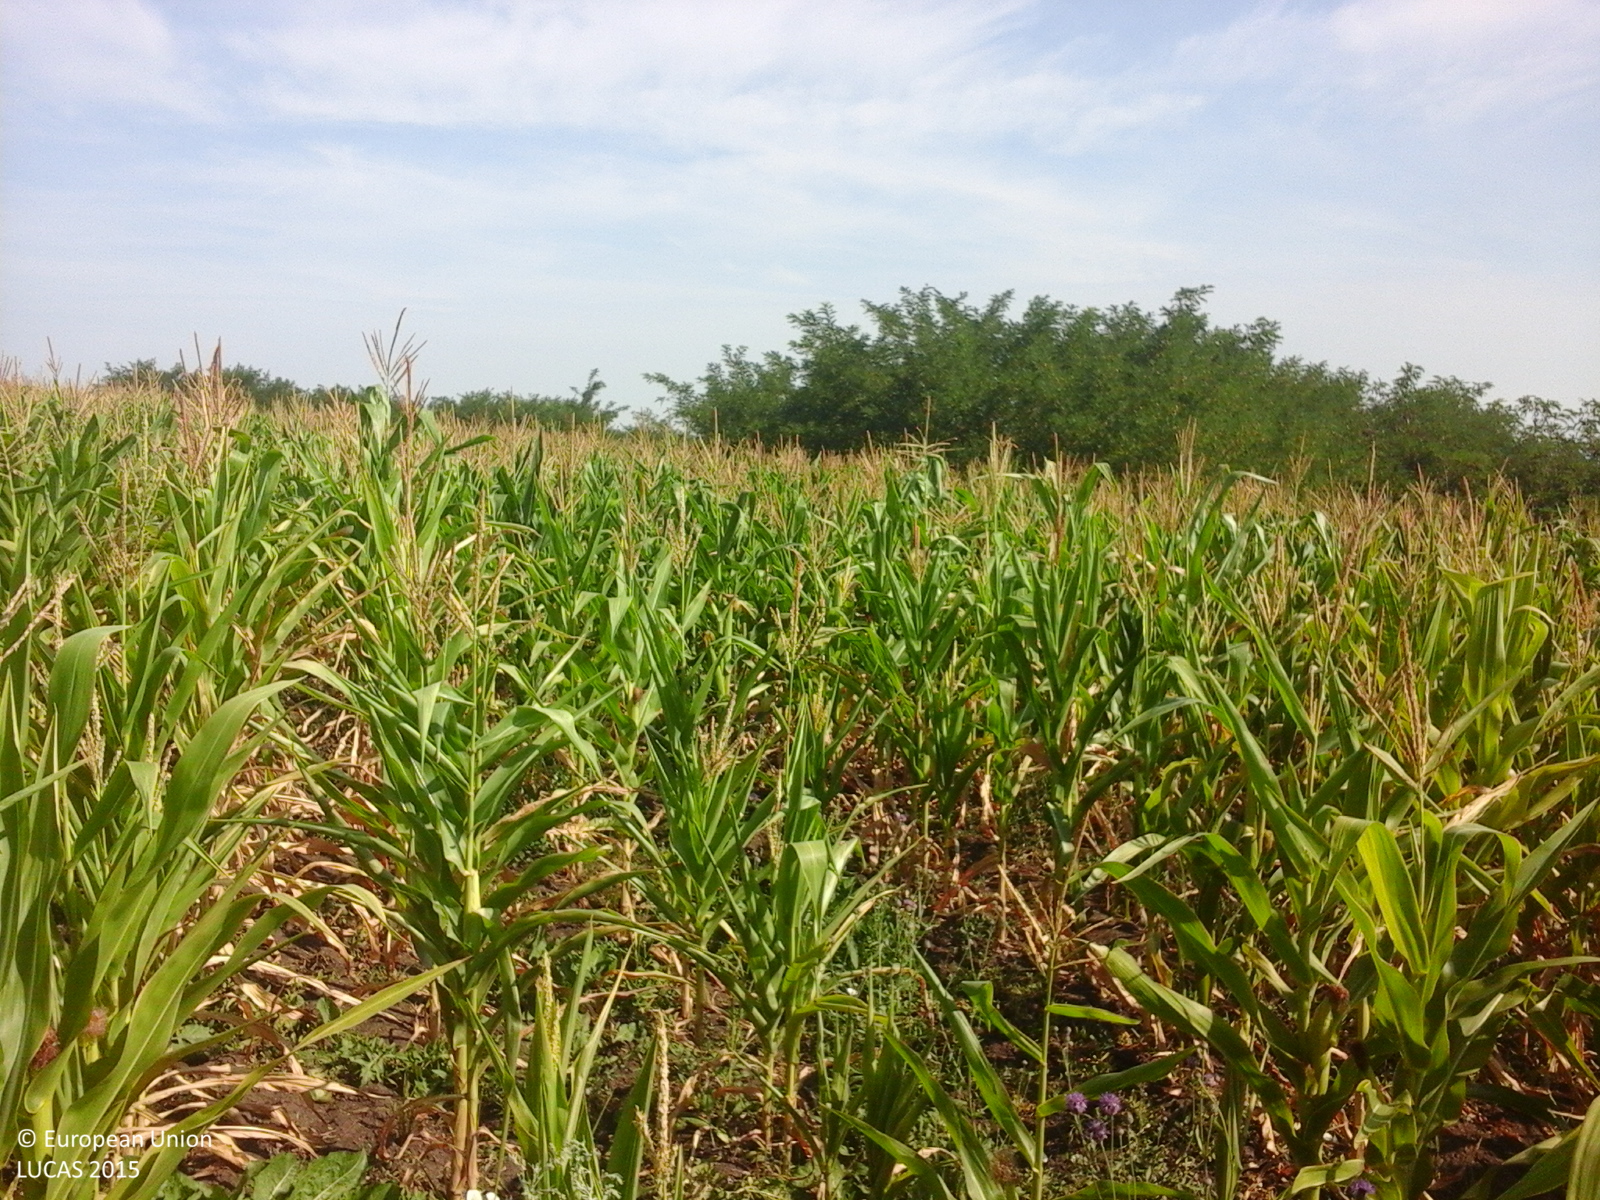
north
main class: Cropland
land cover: Maize
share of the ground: > 75 %
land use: Agriculture (excluding fallow land and kitchen gardens)
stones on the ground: < 10 %
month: July
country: RO
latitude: 46.5531
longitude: 28.1439
